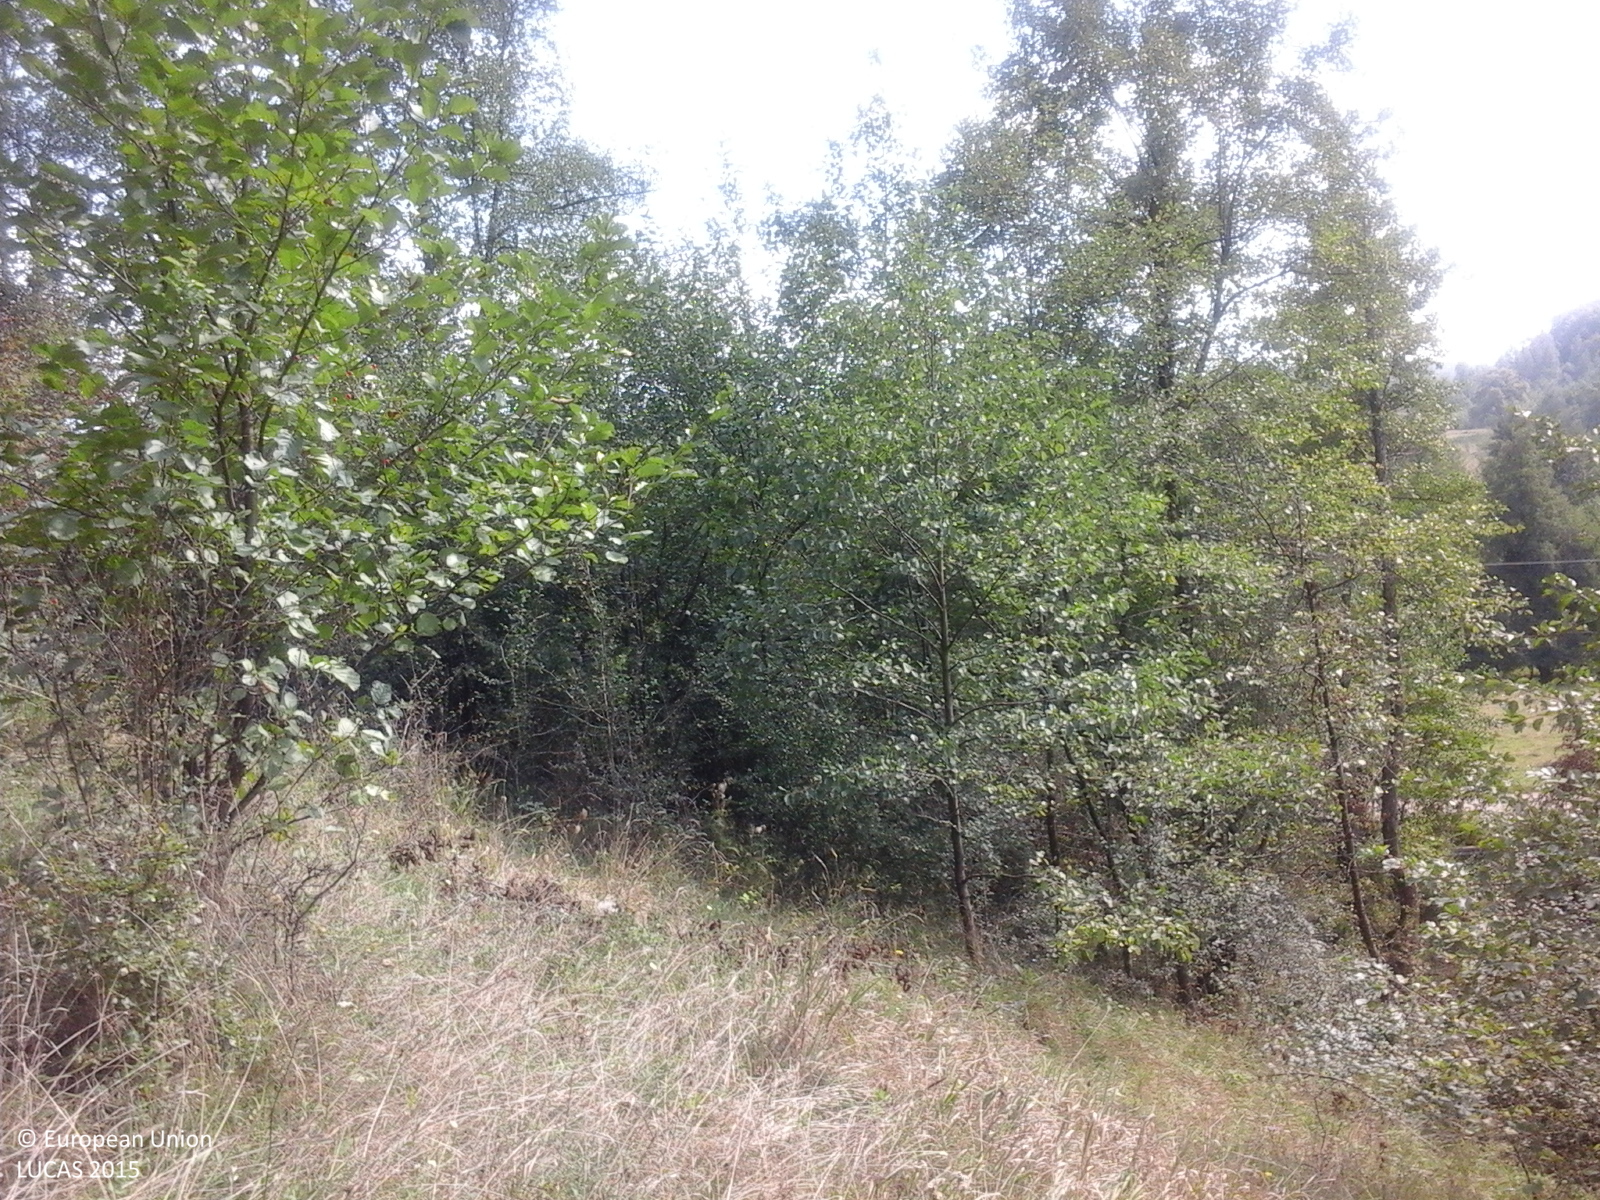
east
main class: Woodland
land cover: Broadleaved woodland
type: beech forest
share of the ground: > 75 %
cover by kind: broadleaved forest trees 100 %
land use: Forestry
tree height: < 5 m
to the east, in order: Broadleaved woodland; Grassland with sparse tree/shrub cover; Shrubland without tree cover; Paved roads, cycling and walking lanes; Grass margins; Electric lines; Grassland without tree/shrub cover
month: September
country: RO
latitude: 47.0164
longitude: 22.9670
